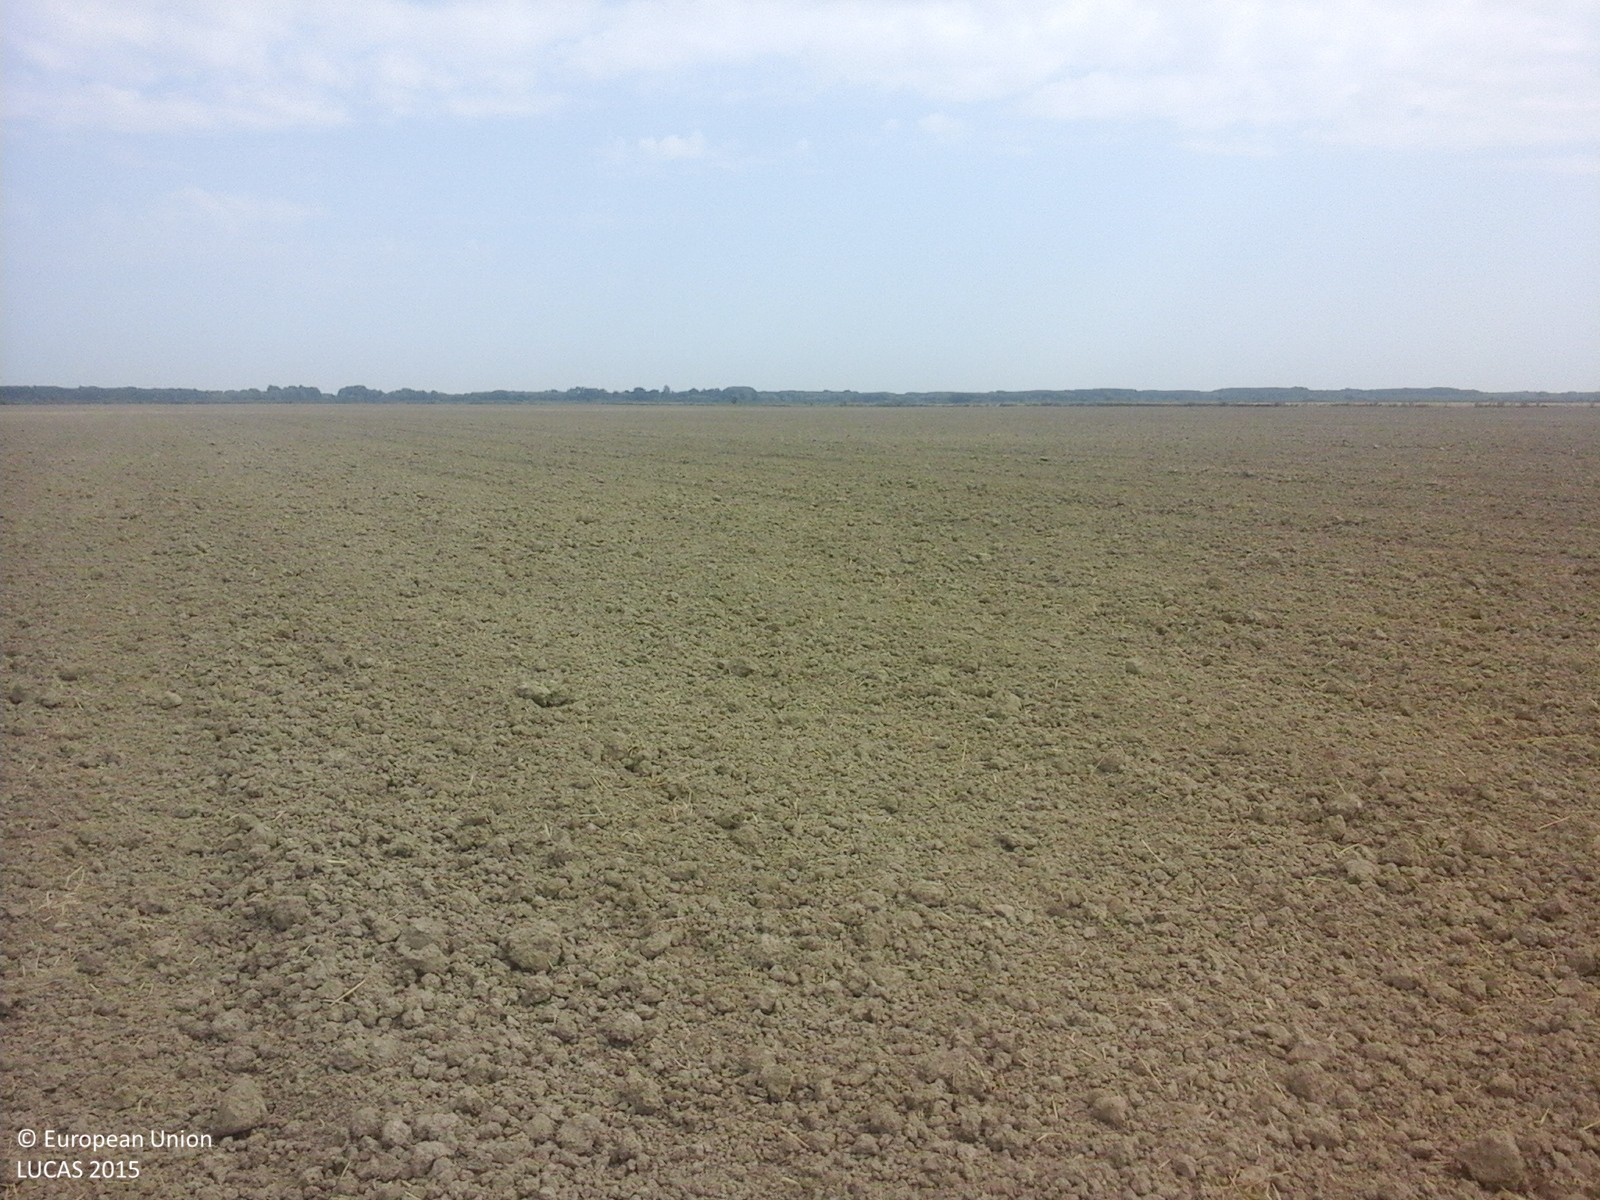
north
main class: Cropland
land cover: Common wheat
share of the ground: < 10 %
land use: Agriculture (excluding fallow land and kitchen gardens)
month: July
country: RO
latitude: 44.5880
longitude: 27.5660
